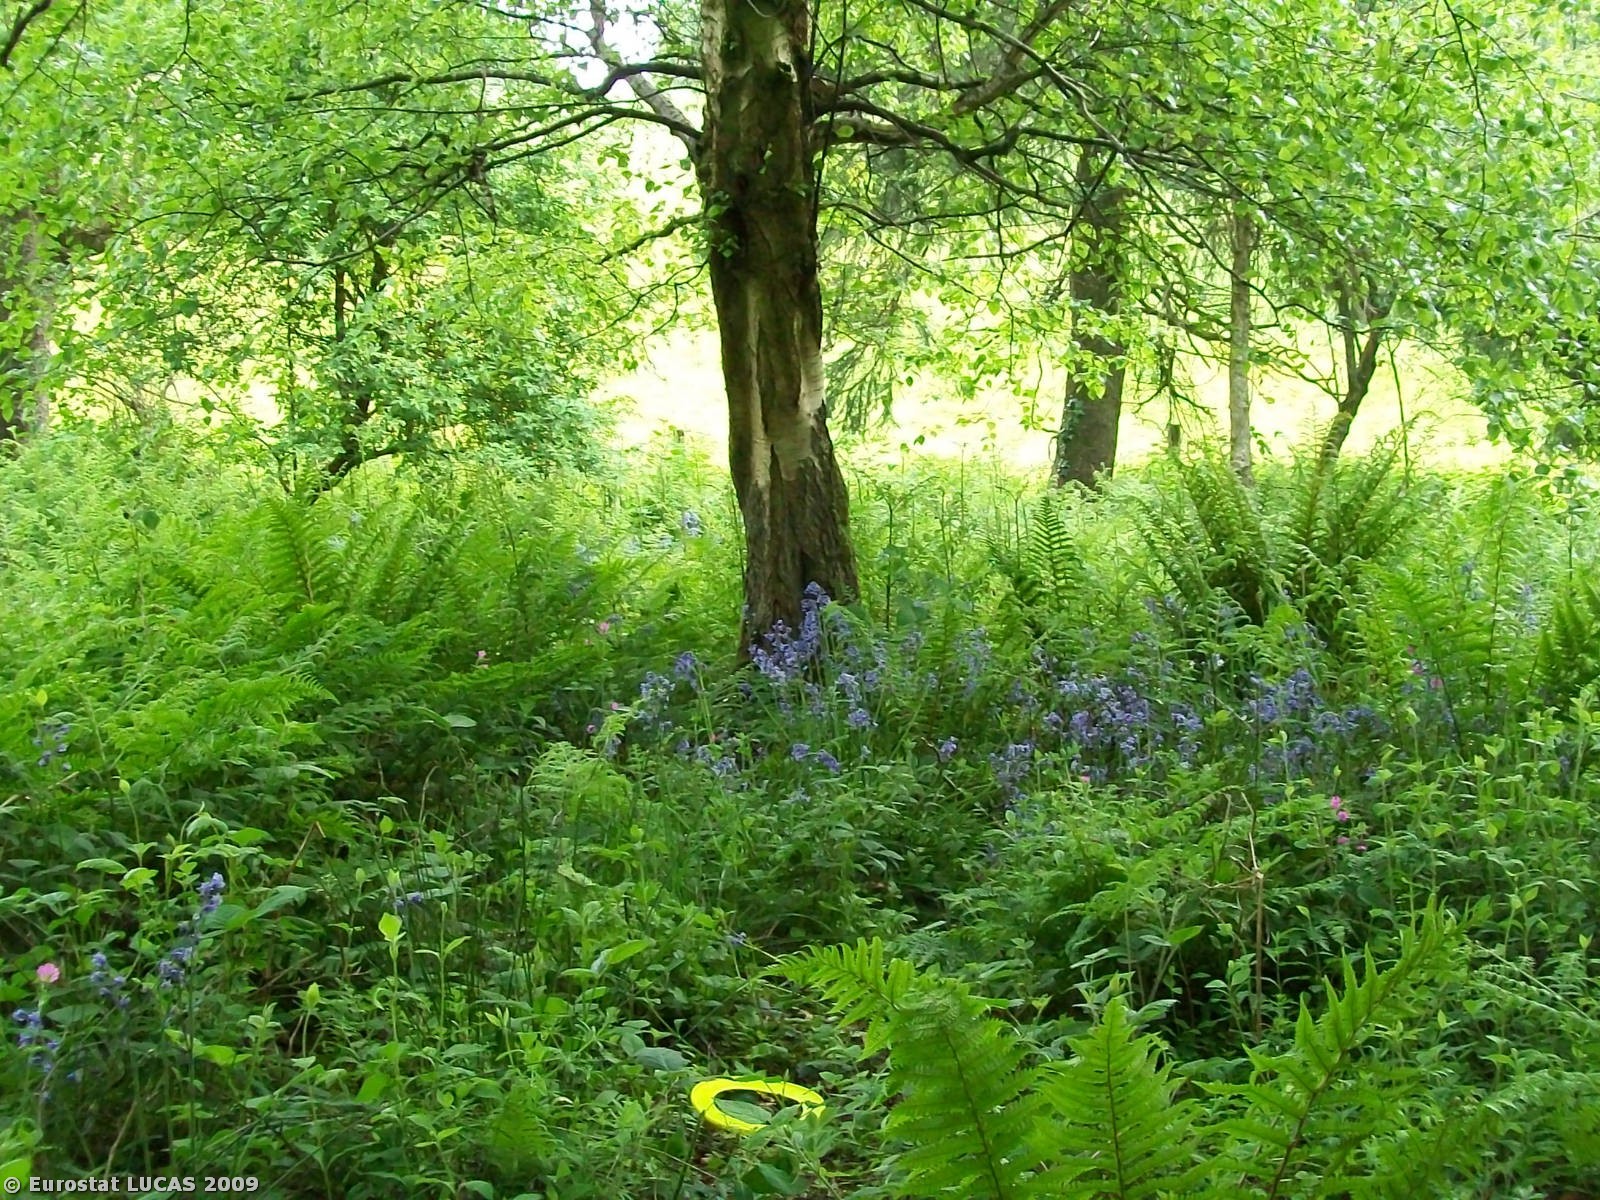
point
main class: Woodland
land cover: Broadleaved woodland
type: mesophytic deciduous forest
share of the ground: > 75 %
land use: Unused
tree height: > 5 m
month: May
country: GB
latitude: 51.0245
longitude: -2.1363
